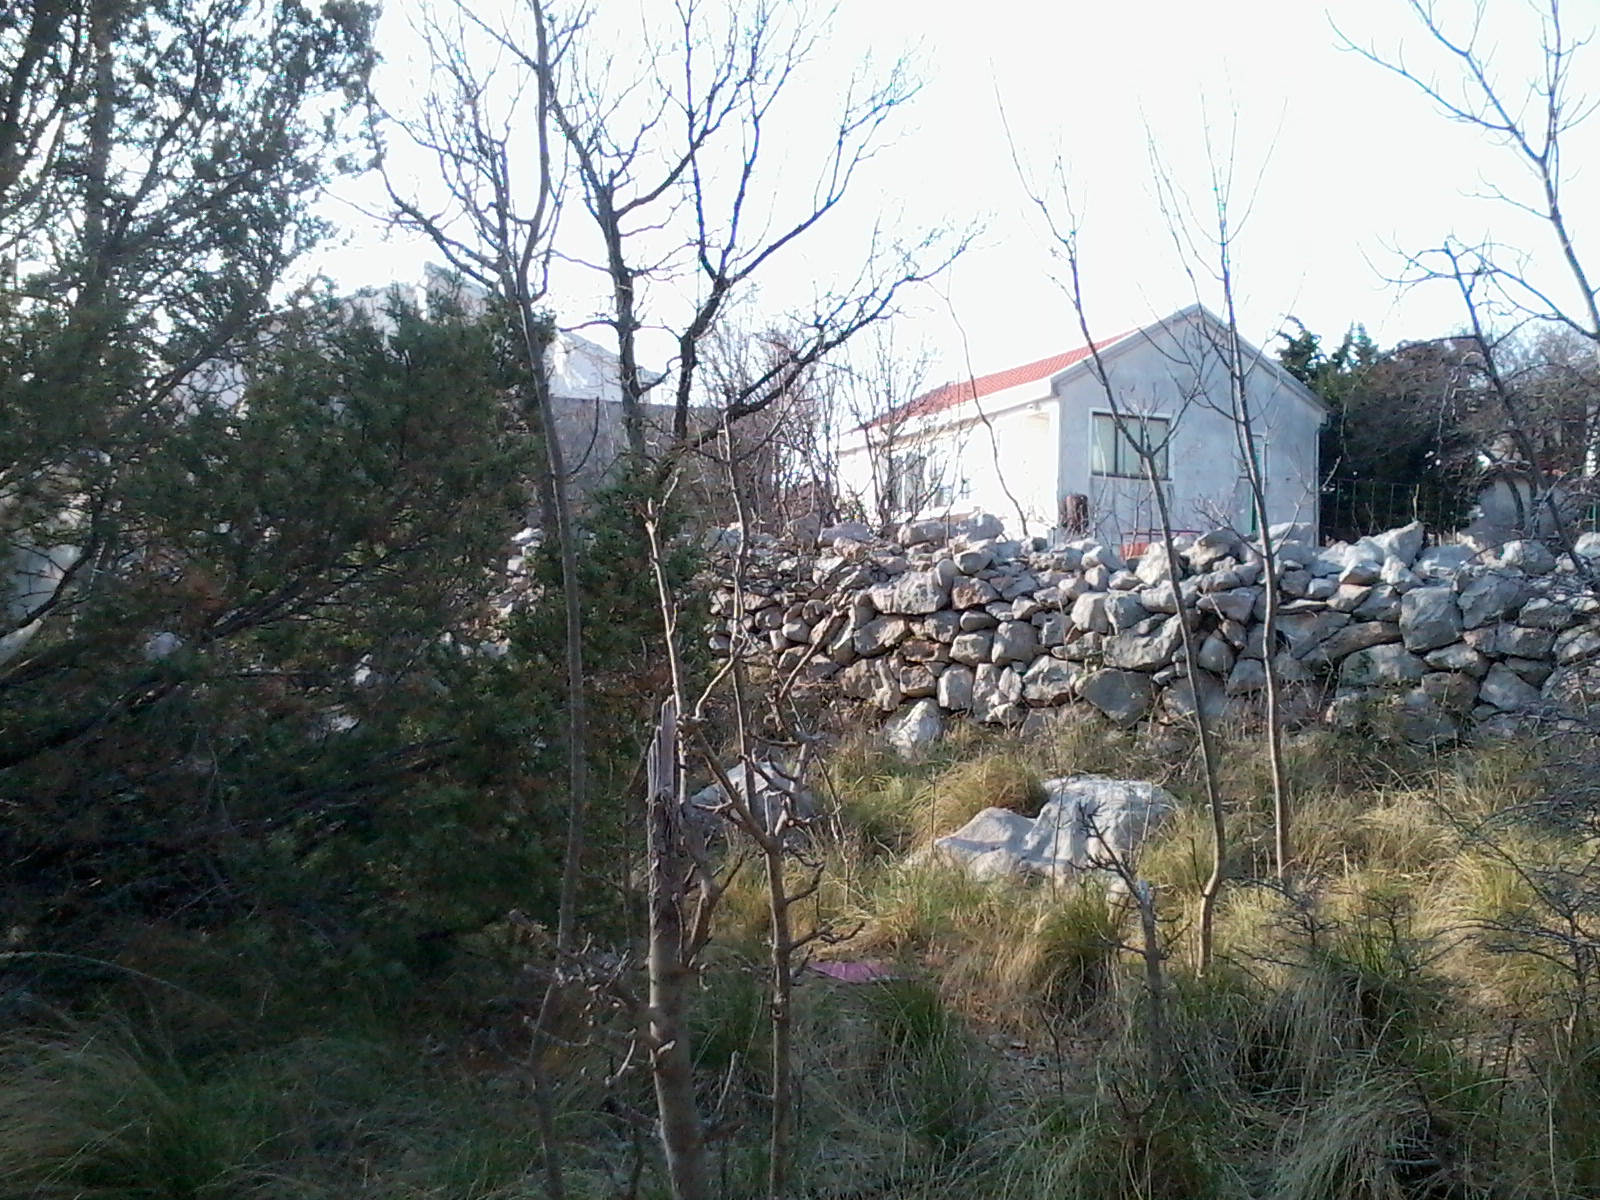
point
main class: Woodland
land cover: Broadleaved woodland
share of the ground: 25 - 50 %
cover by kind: broadleaved forest trees 30 %, herbaceous plants 30 %, shrubs 25 %, consolidated bare surface 10 %, coniferous forest trees 5 %
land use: Abandoned areas
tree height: < 5 m
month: April
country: HR
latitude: 44.2774
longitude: 15.4930
